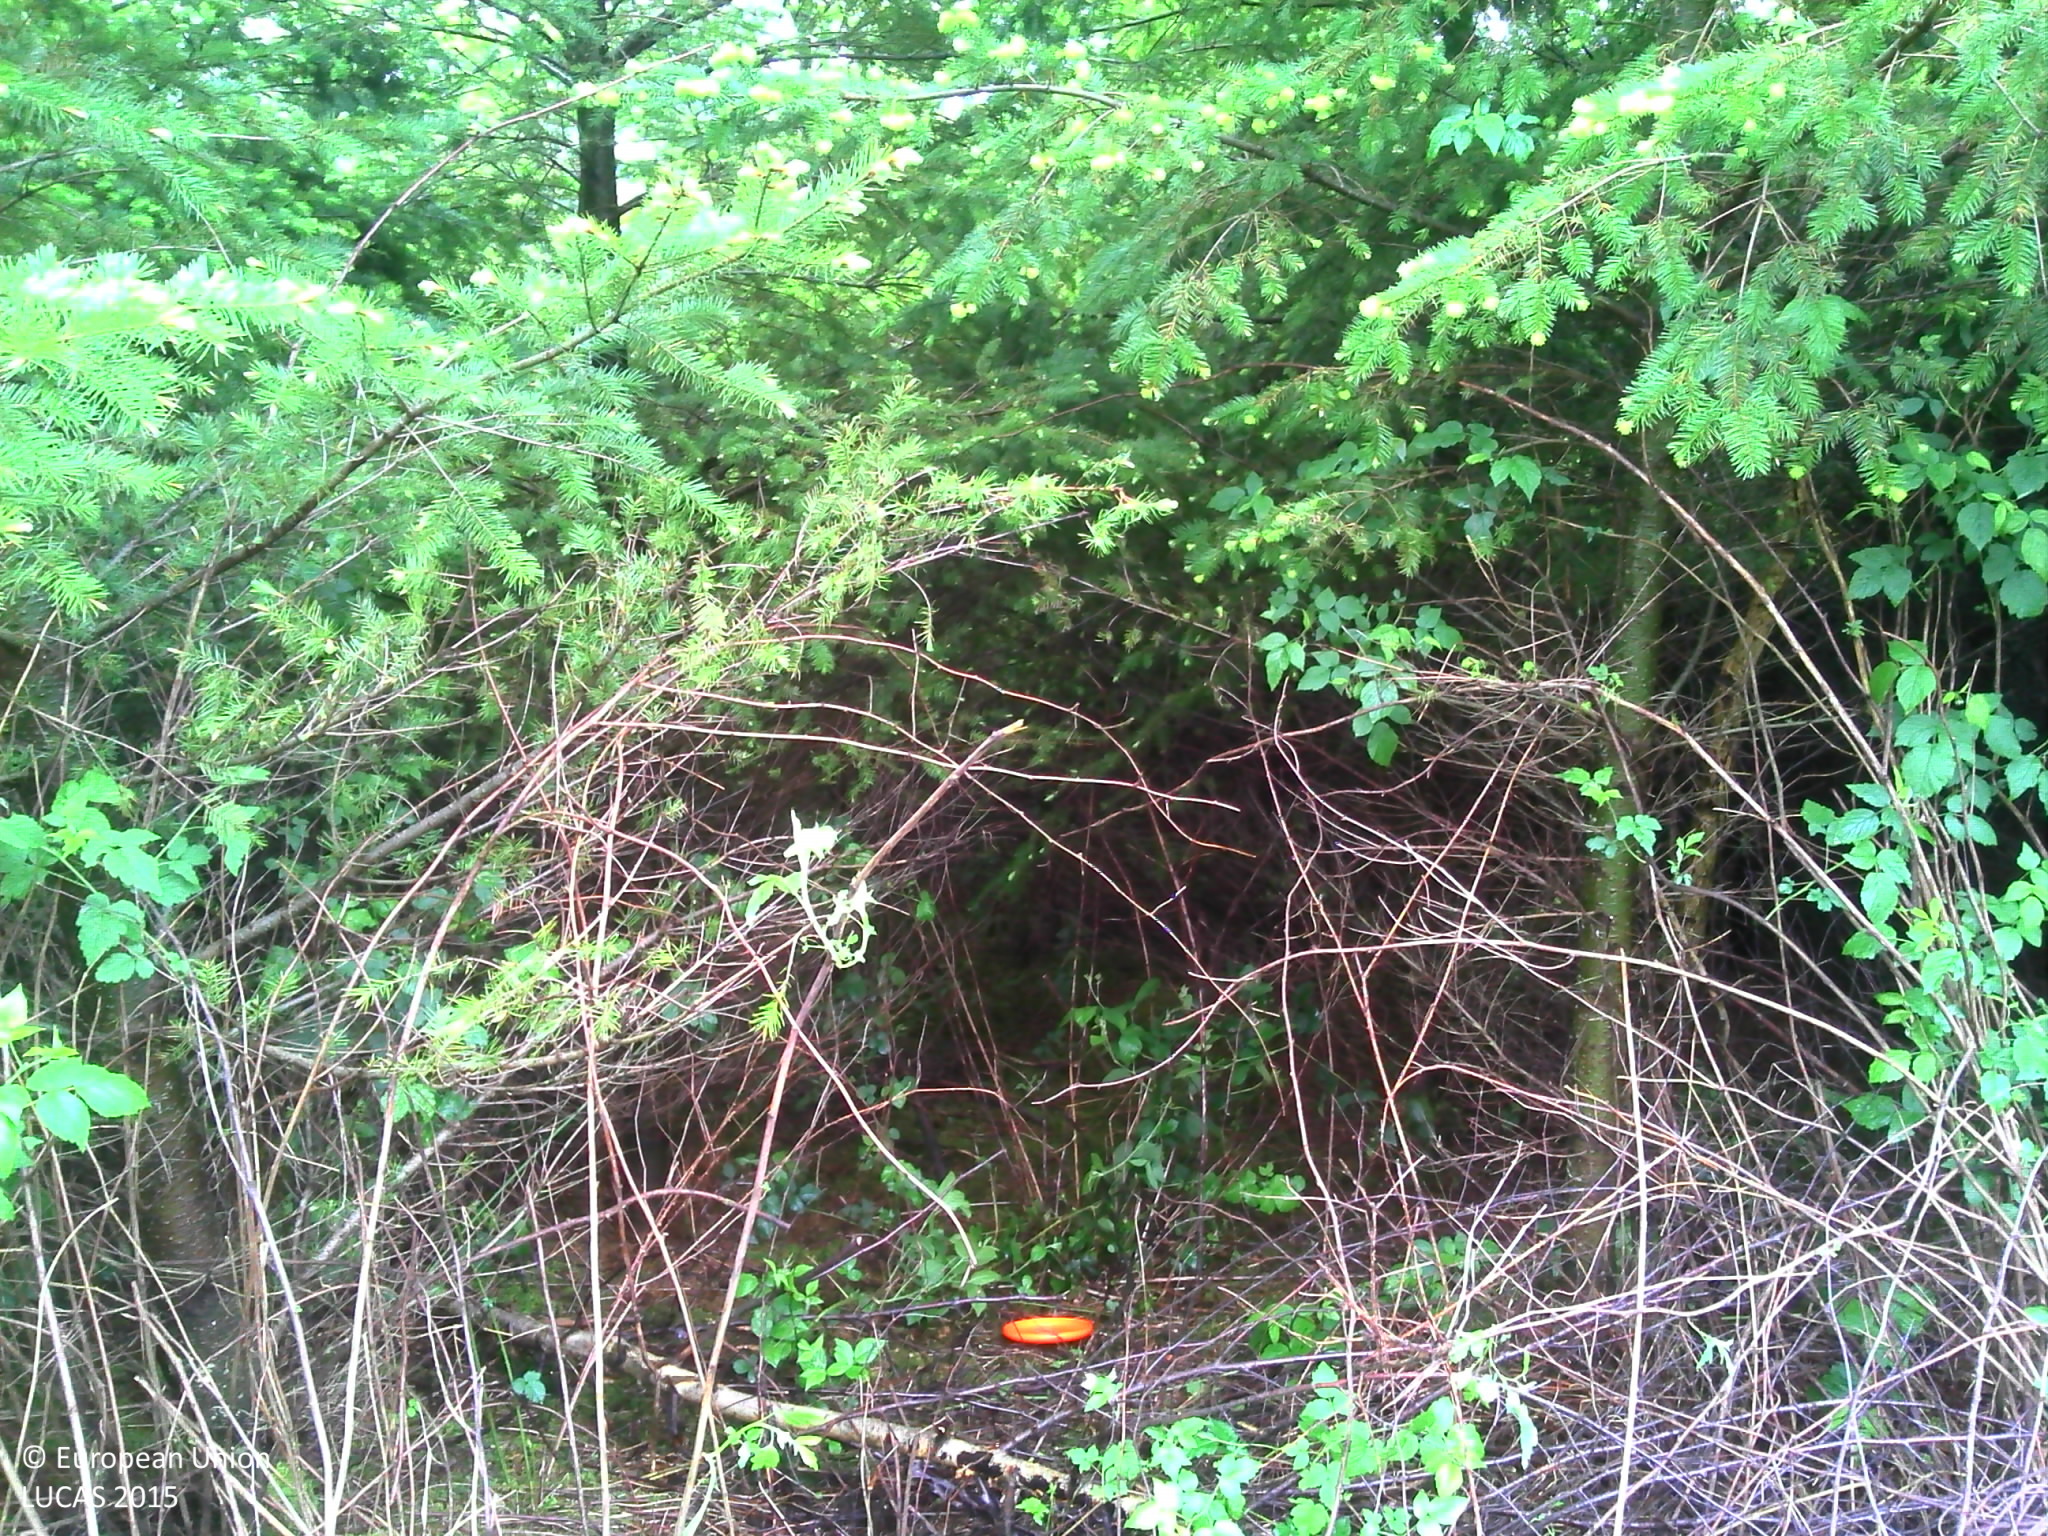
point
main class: Woodland
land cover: Other coniferous woodland
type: exotic forest
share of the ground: > 75 %
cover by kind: coniferous forest trees 85 %, broadleaved forest trees 10 %, lichens and mosses 5 %
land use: Forestry
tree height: > 5 m
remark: Burnt area
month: June
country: BE
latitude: 50.3388
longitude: 5.7414
